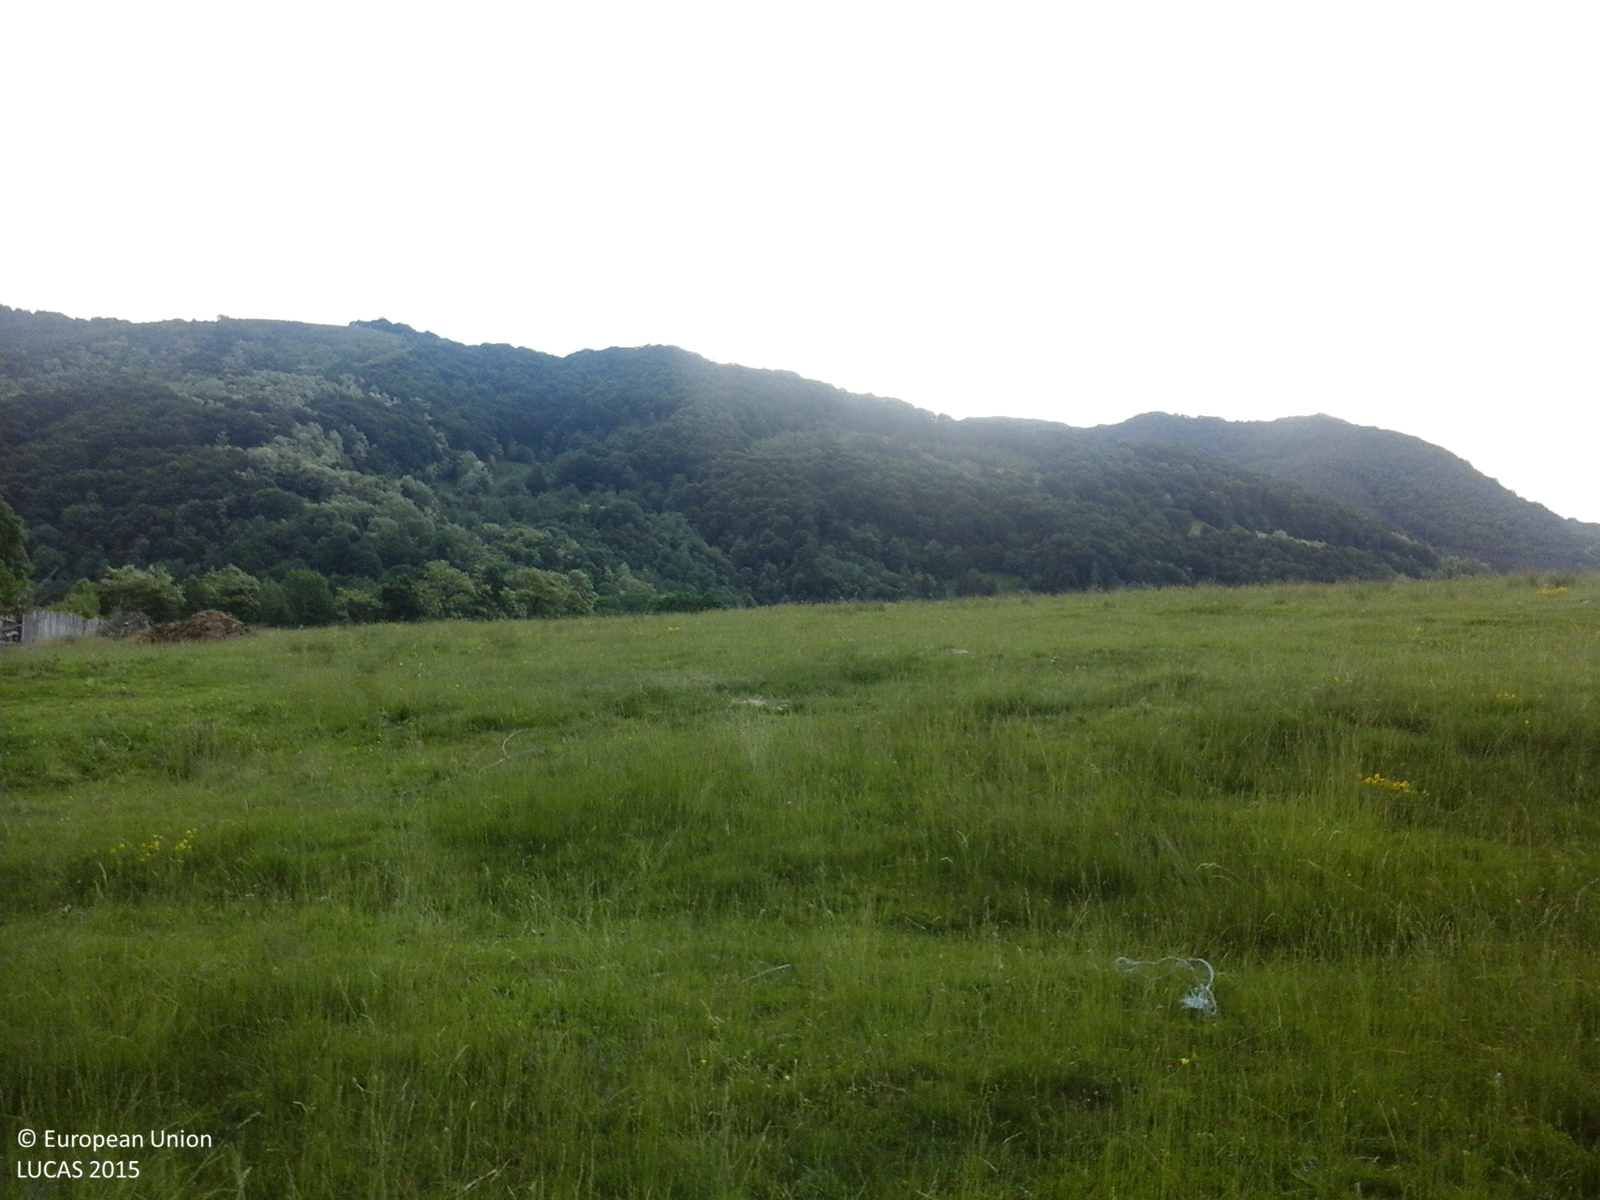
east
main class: Grassland
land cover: Grassland without tree/shrub cover
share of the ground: > 75 %
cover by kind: herbaceous plants 100 %
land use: Agriculture (excluding fallow land and kitchen gardens)
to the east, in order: Grassland without tree/shrub cover; Fences; Grassland without tree/shrub cover
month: May
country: RO
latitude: 45.6913
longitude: 25.2363
